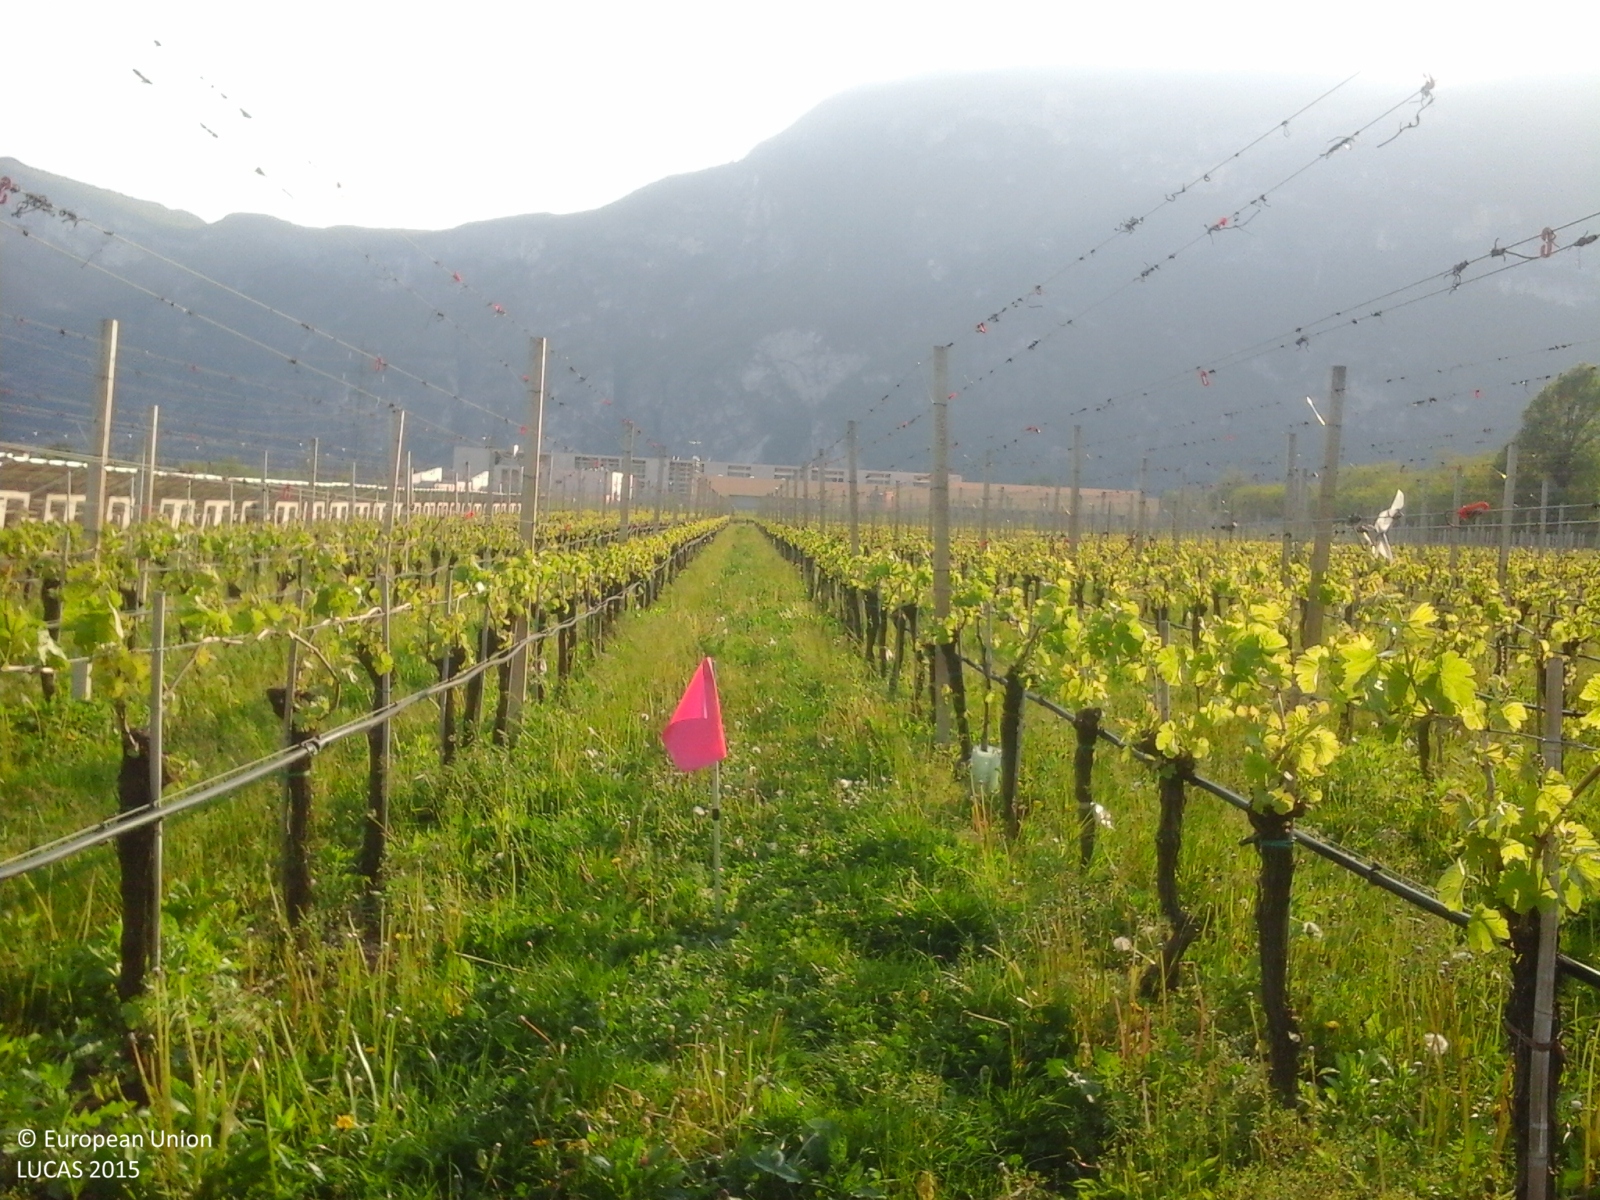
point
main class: Cropland
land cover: Vineyards
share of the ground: < 10 %
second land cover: Grassland without tree/shrub cover
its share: > 75 %
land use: Agriculture (excluding fallow land and kitchen gardens)
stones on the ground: < 10 %
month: April
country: IT
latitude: 46.1294
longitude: 11.0986
